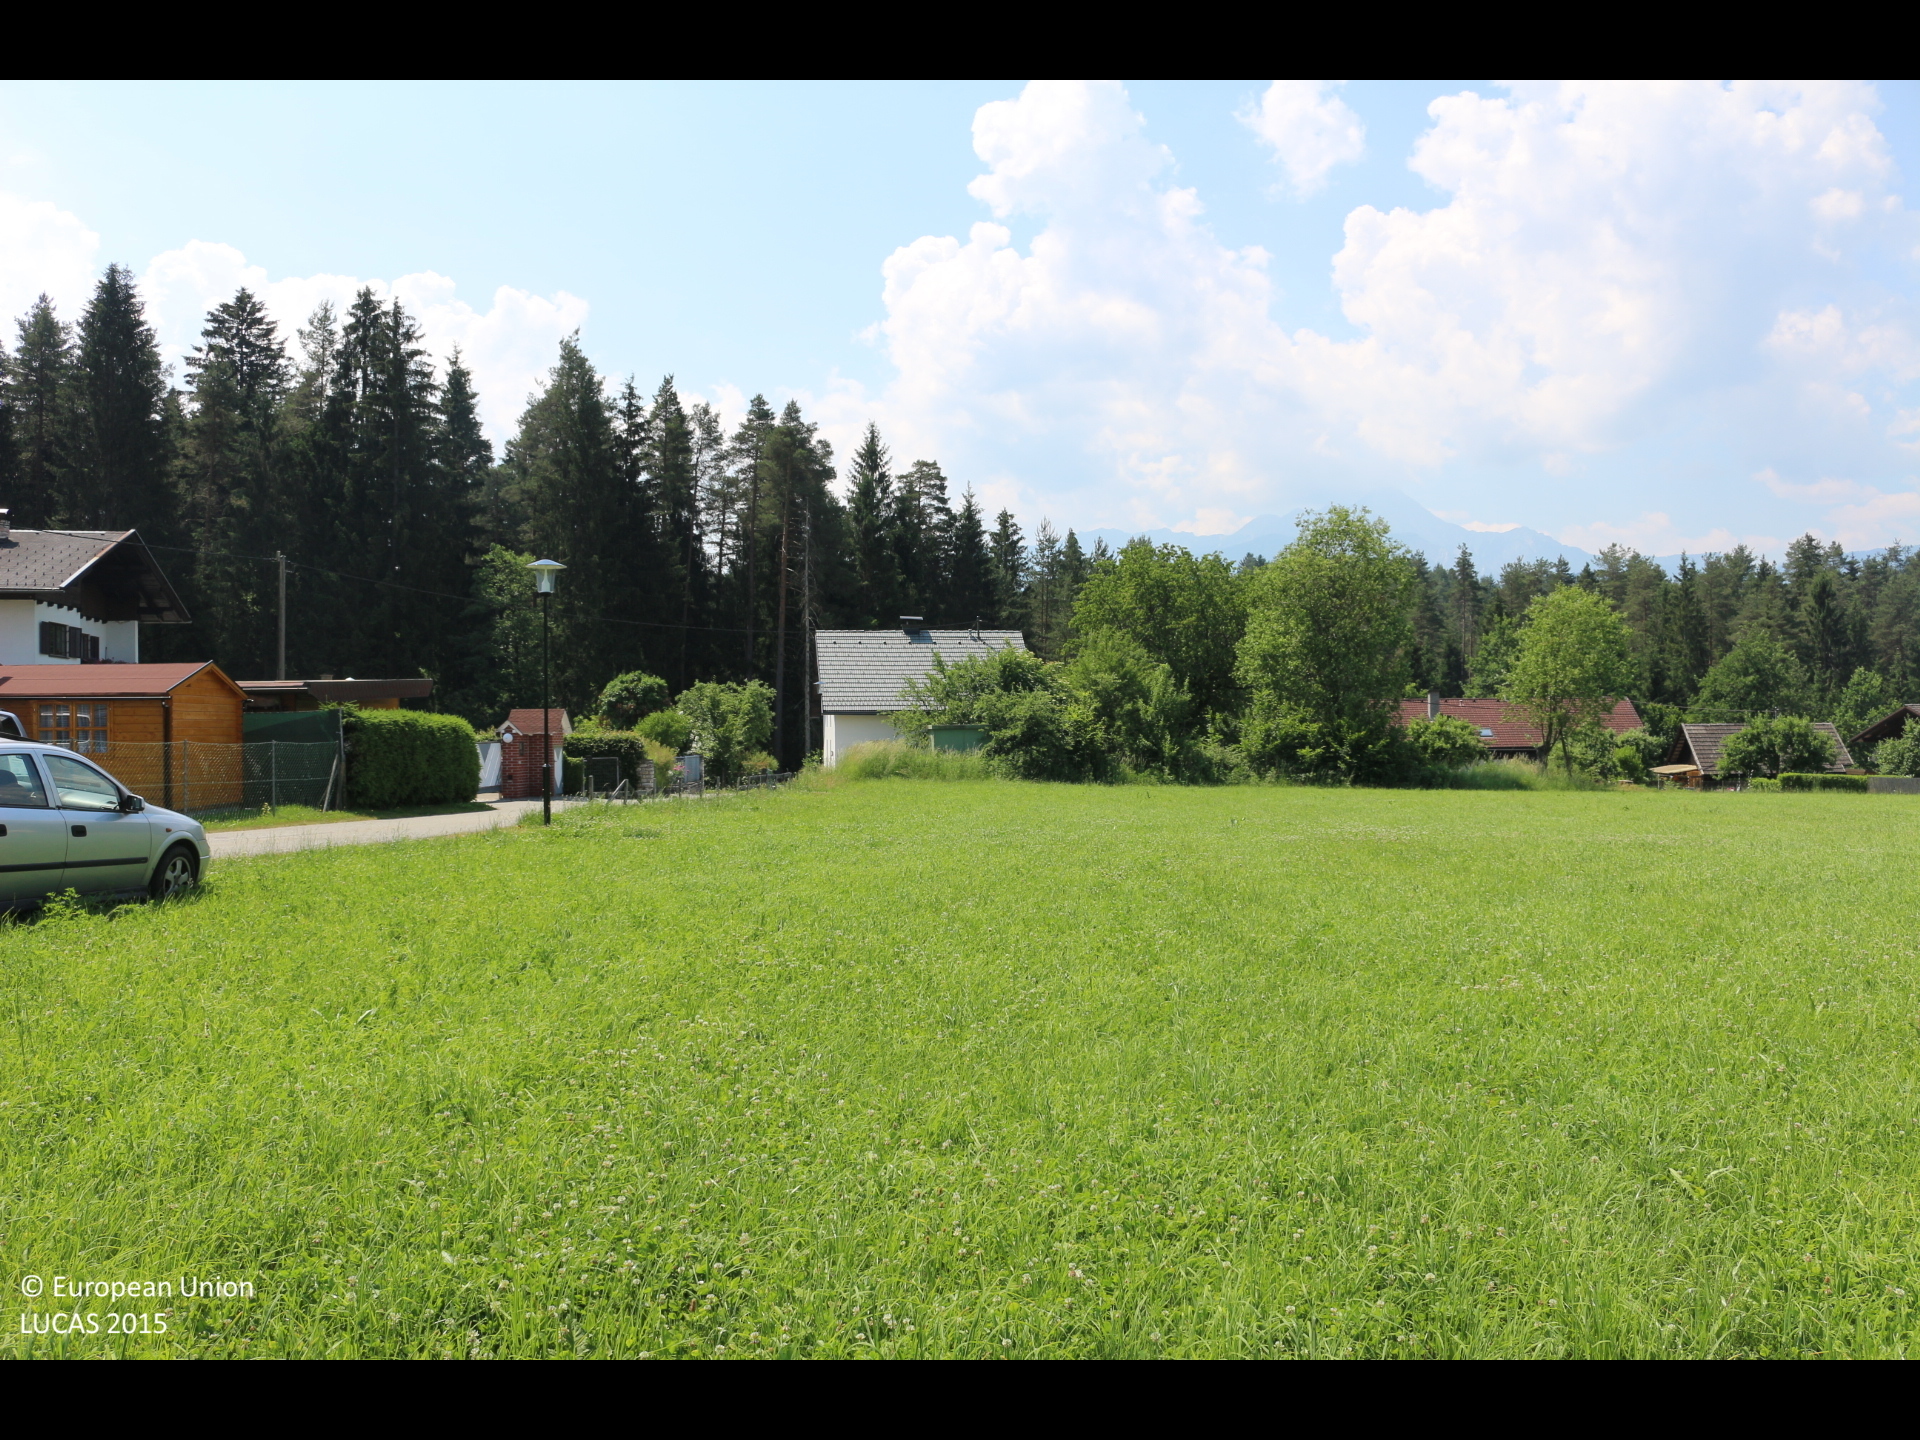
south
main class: Grassland
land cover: Grassland without tree/shrub cover
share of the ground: > 75 %
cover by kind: herbaceous plants 100 %
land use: Agriculture (excluding fallow land and kitchen gardens)
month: June
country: AT
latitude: 46.6008
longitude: 14.0049
